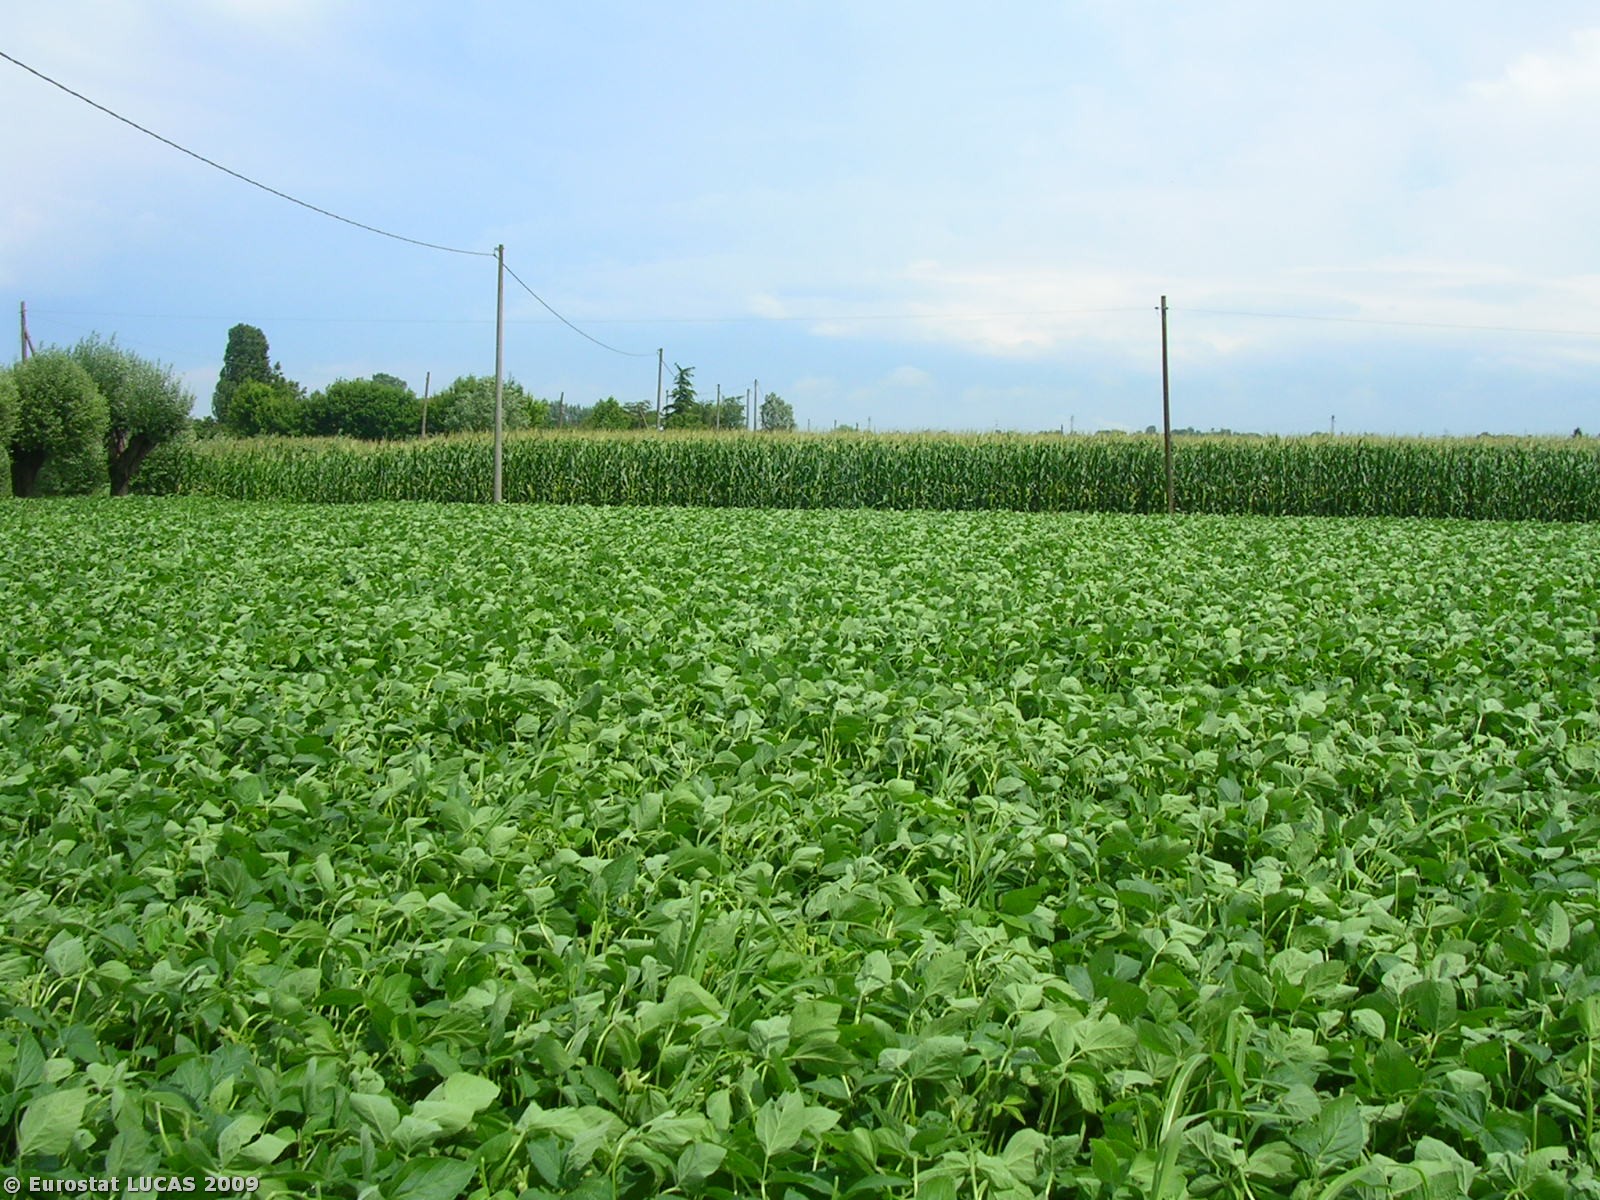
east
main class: Cropland
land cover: Soya
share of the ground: > 75 %
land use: Agriculture (excluding fallow land and kitchen gardens)
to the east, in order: Soya; Electric lines; Maize; Abandoned hedges; Grass margins; Ditches and canals; Grass margins; Electric lines; Tracks; Grass margins; Soya; Fences; Grassland with sparse tree/shrub cover; Artificial constructions in urban areas; Grass margins; Tracks; Grass margins; Paved roads, cycling and walking lanes
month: July
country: IT
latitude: 45.2131
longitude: 12.0974
